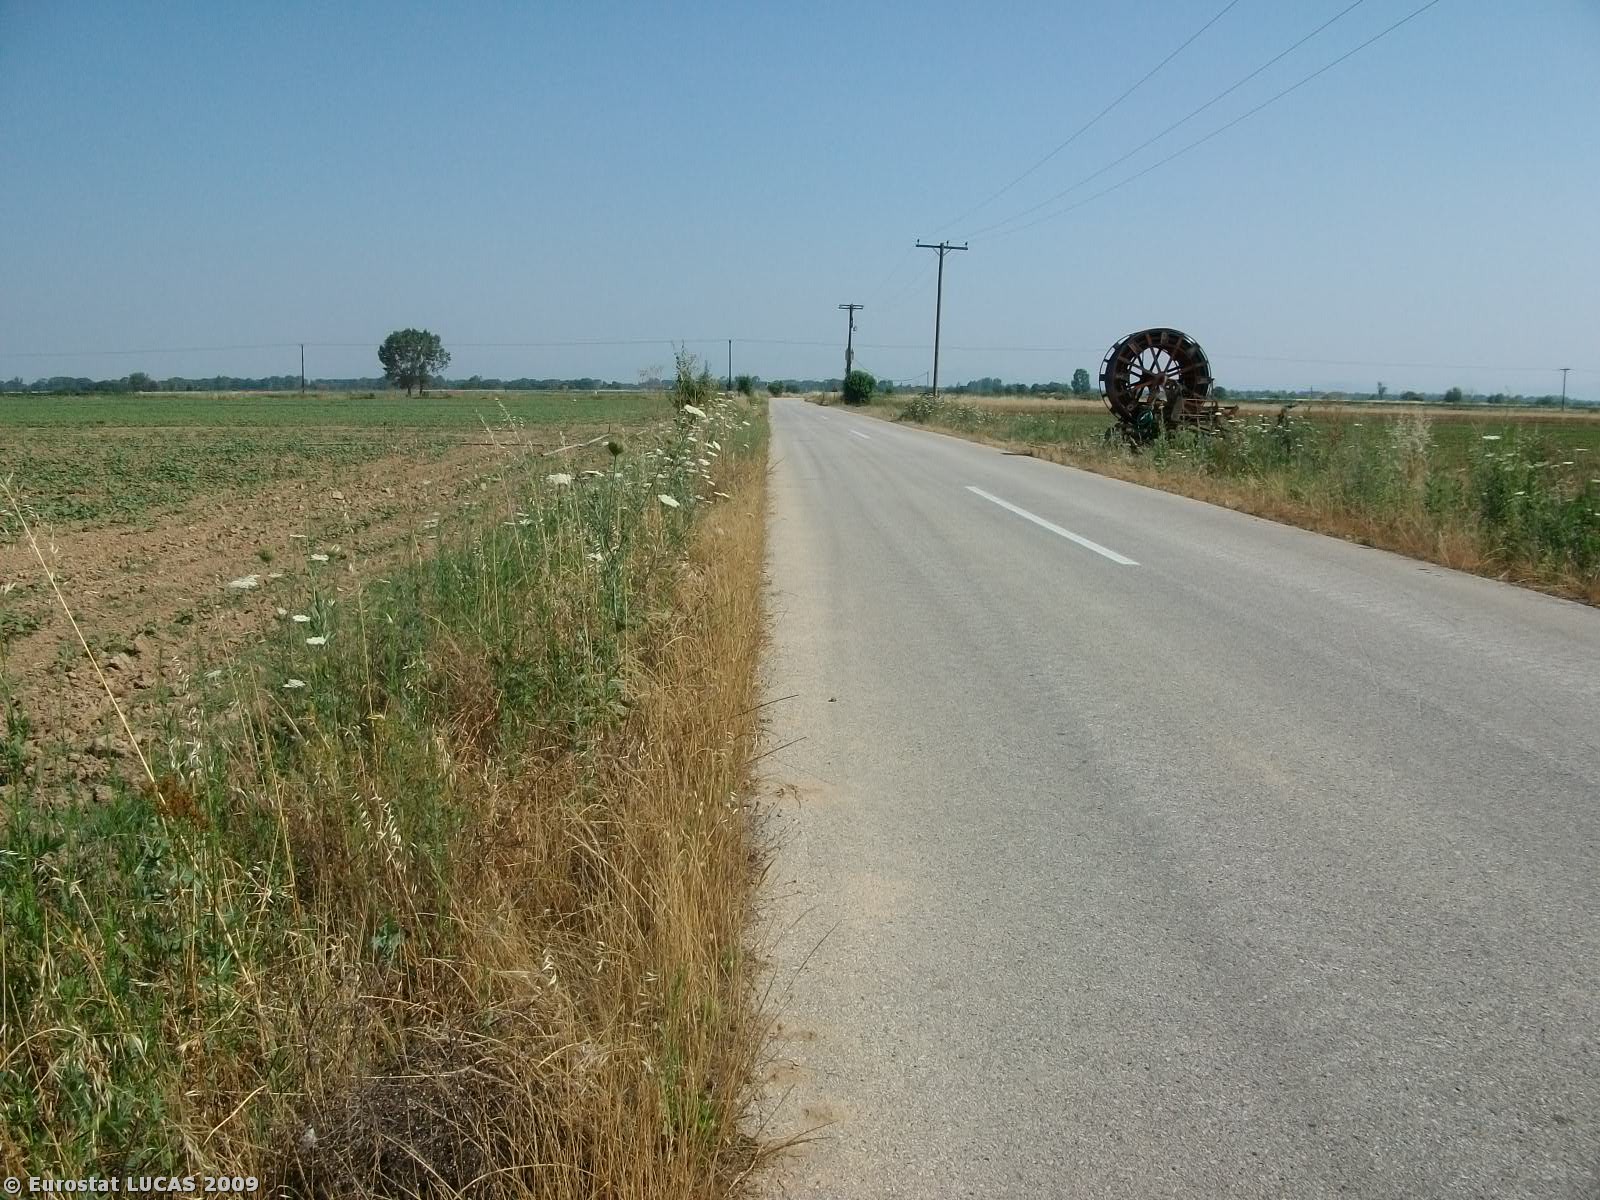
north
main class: Grassland
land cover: Spontaneously vegetated surfaces
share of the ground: > 75 %
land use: Unused
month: June
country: GR
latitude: 39.3161
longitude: 21.9398
